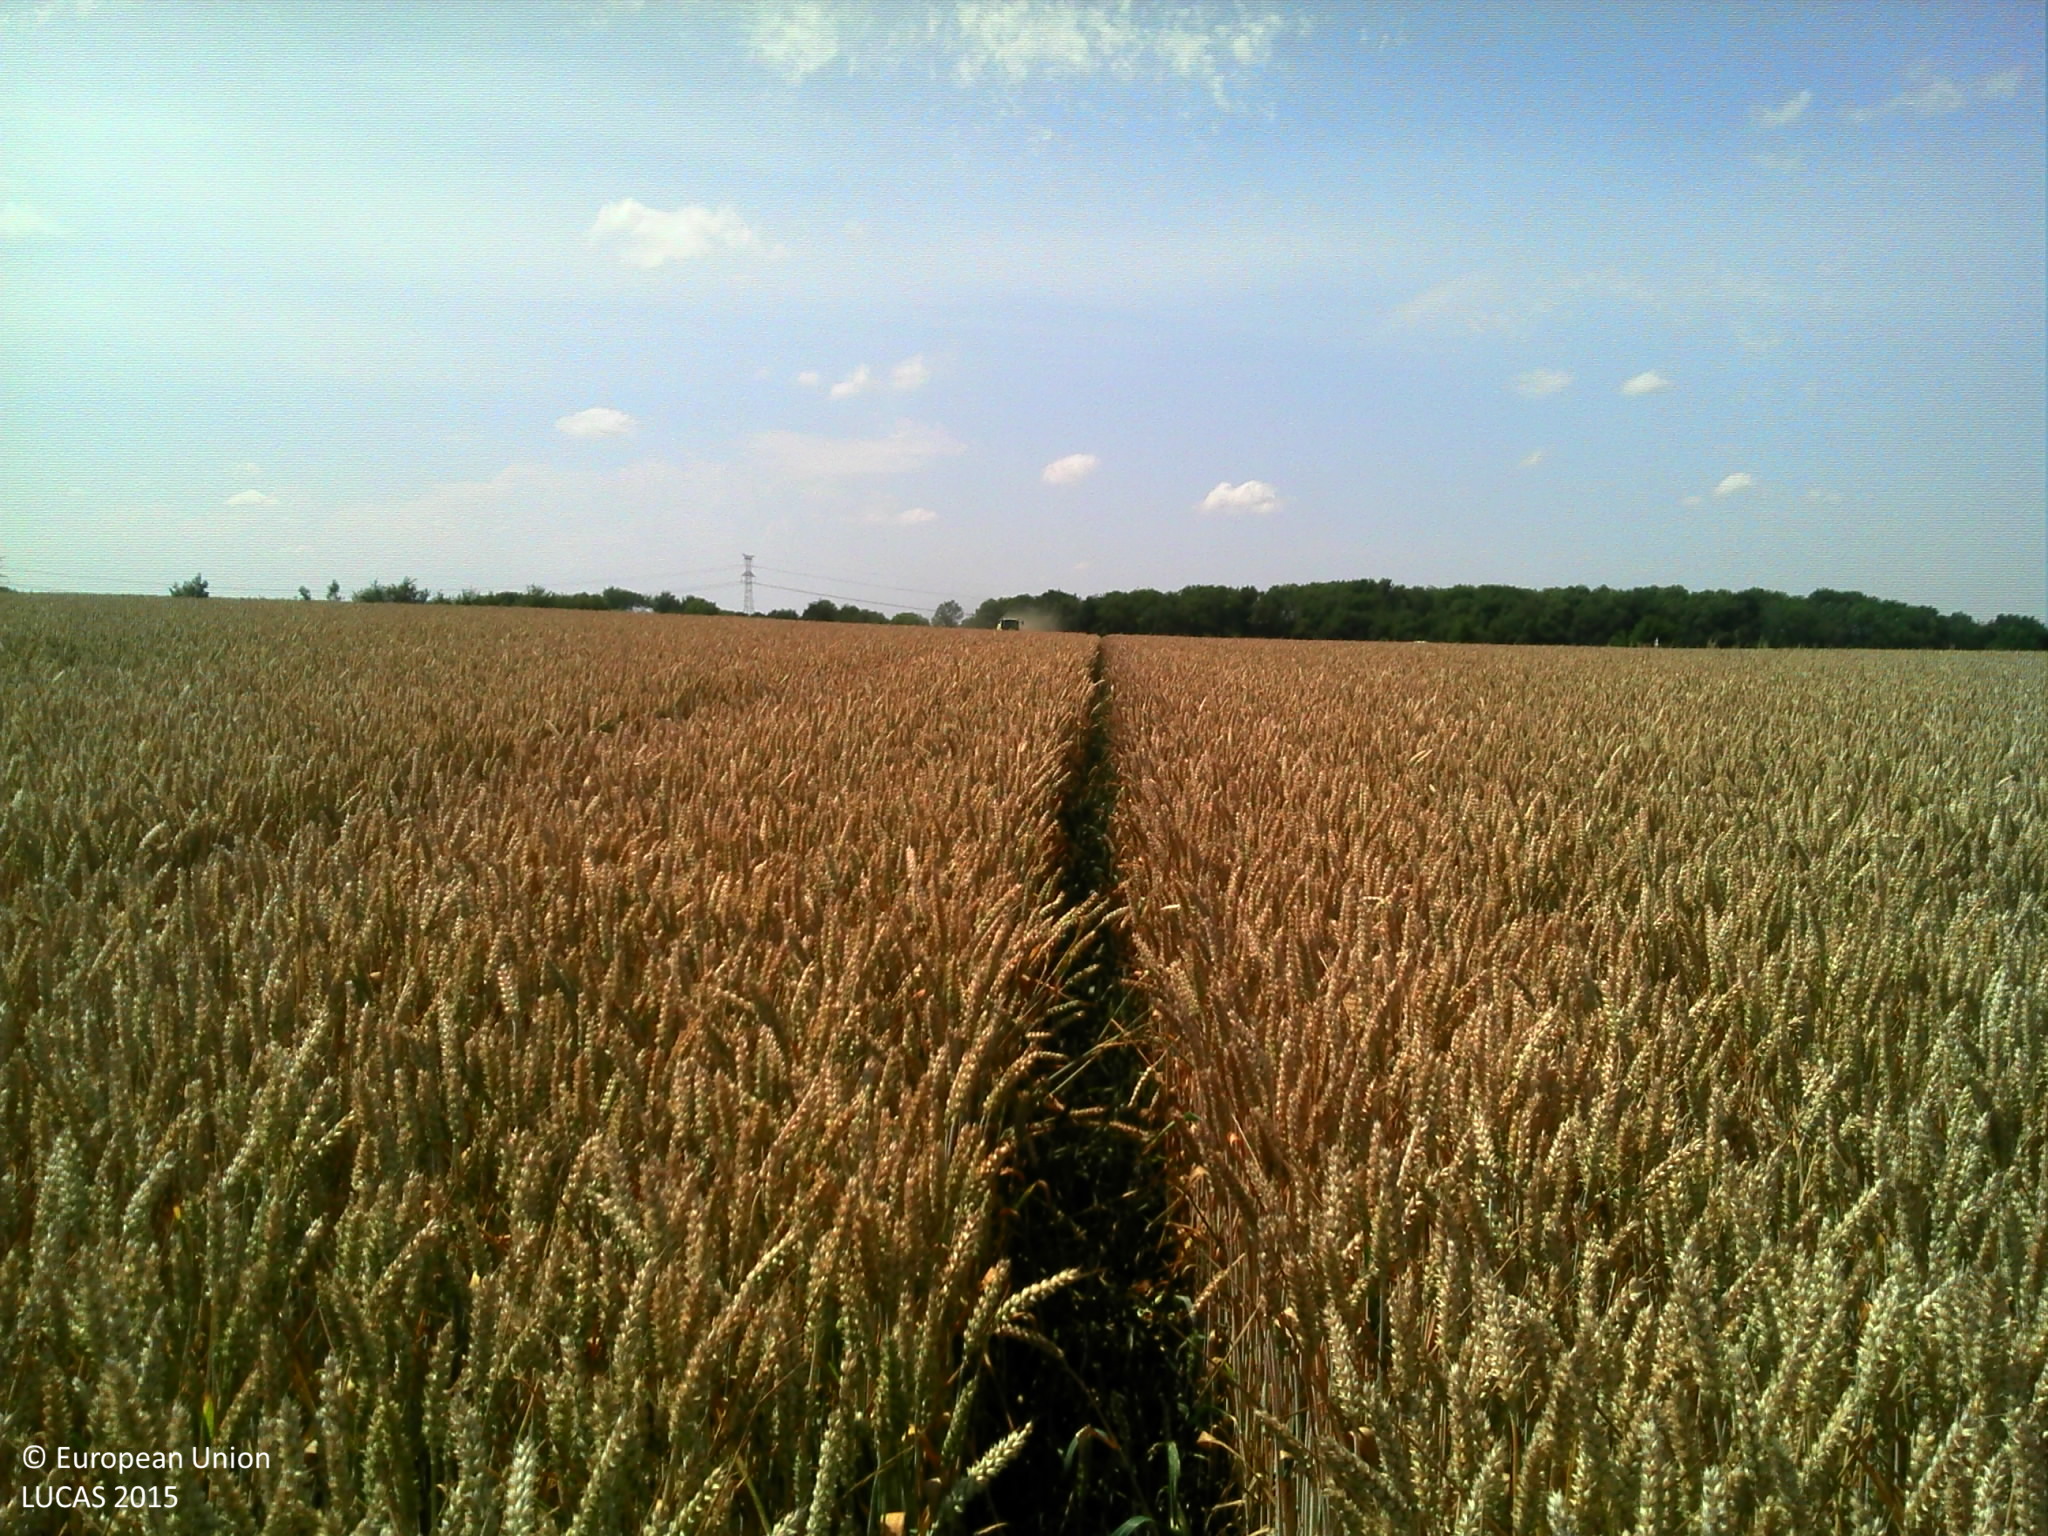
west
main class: Cropland
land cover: Common wheat
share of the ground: > 75 %
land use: Agriculture (excluding fallow land and kitchen gardens)
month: July
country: FR
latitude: 50.0279
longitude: 2.2387
